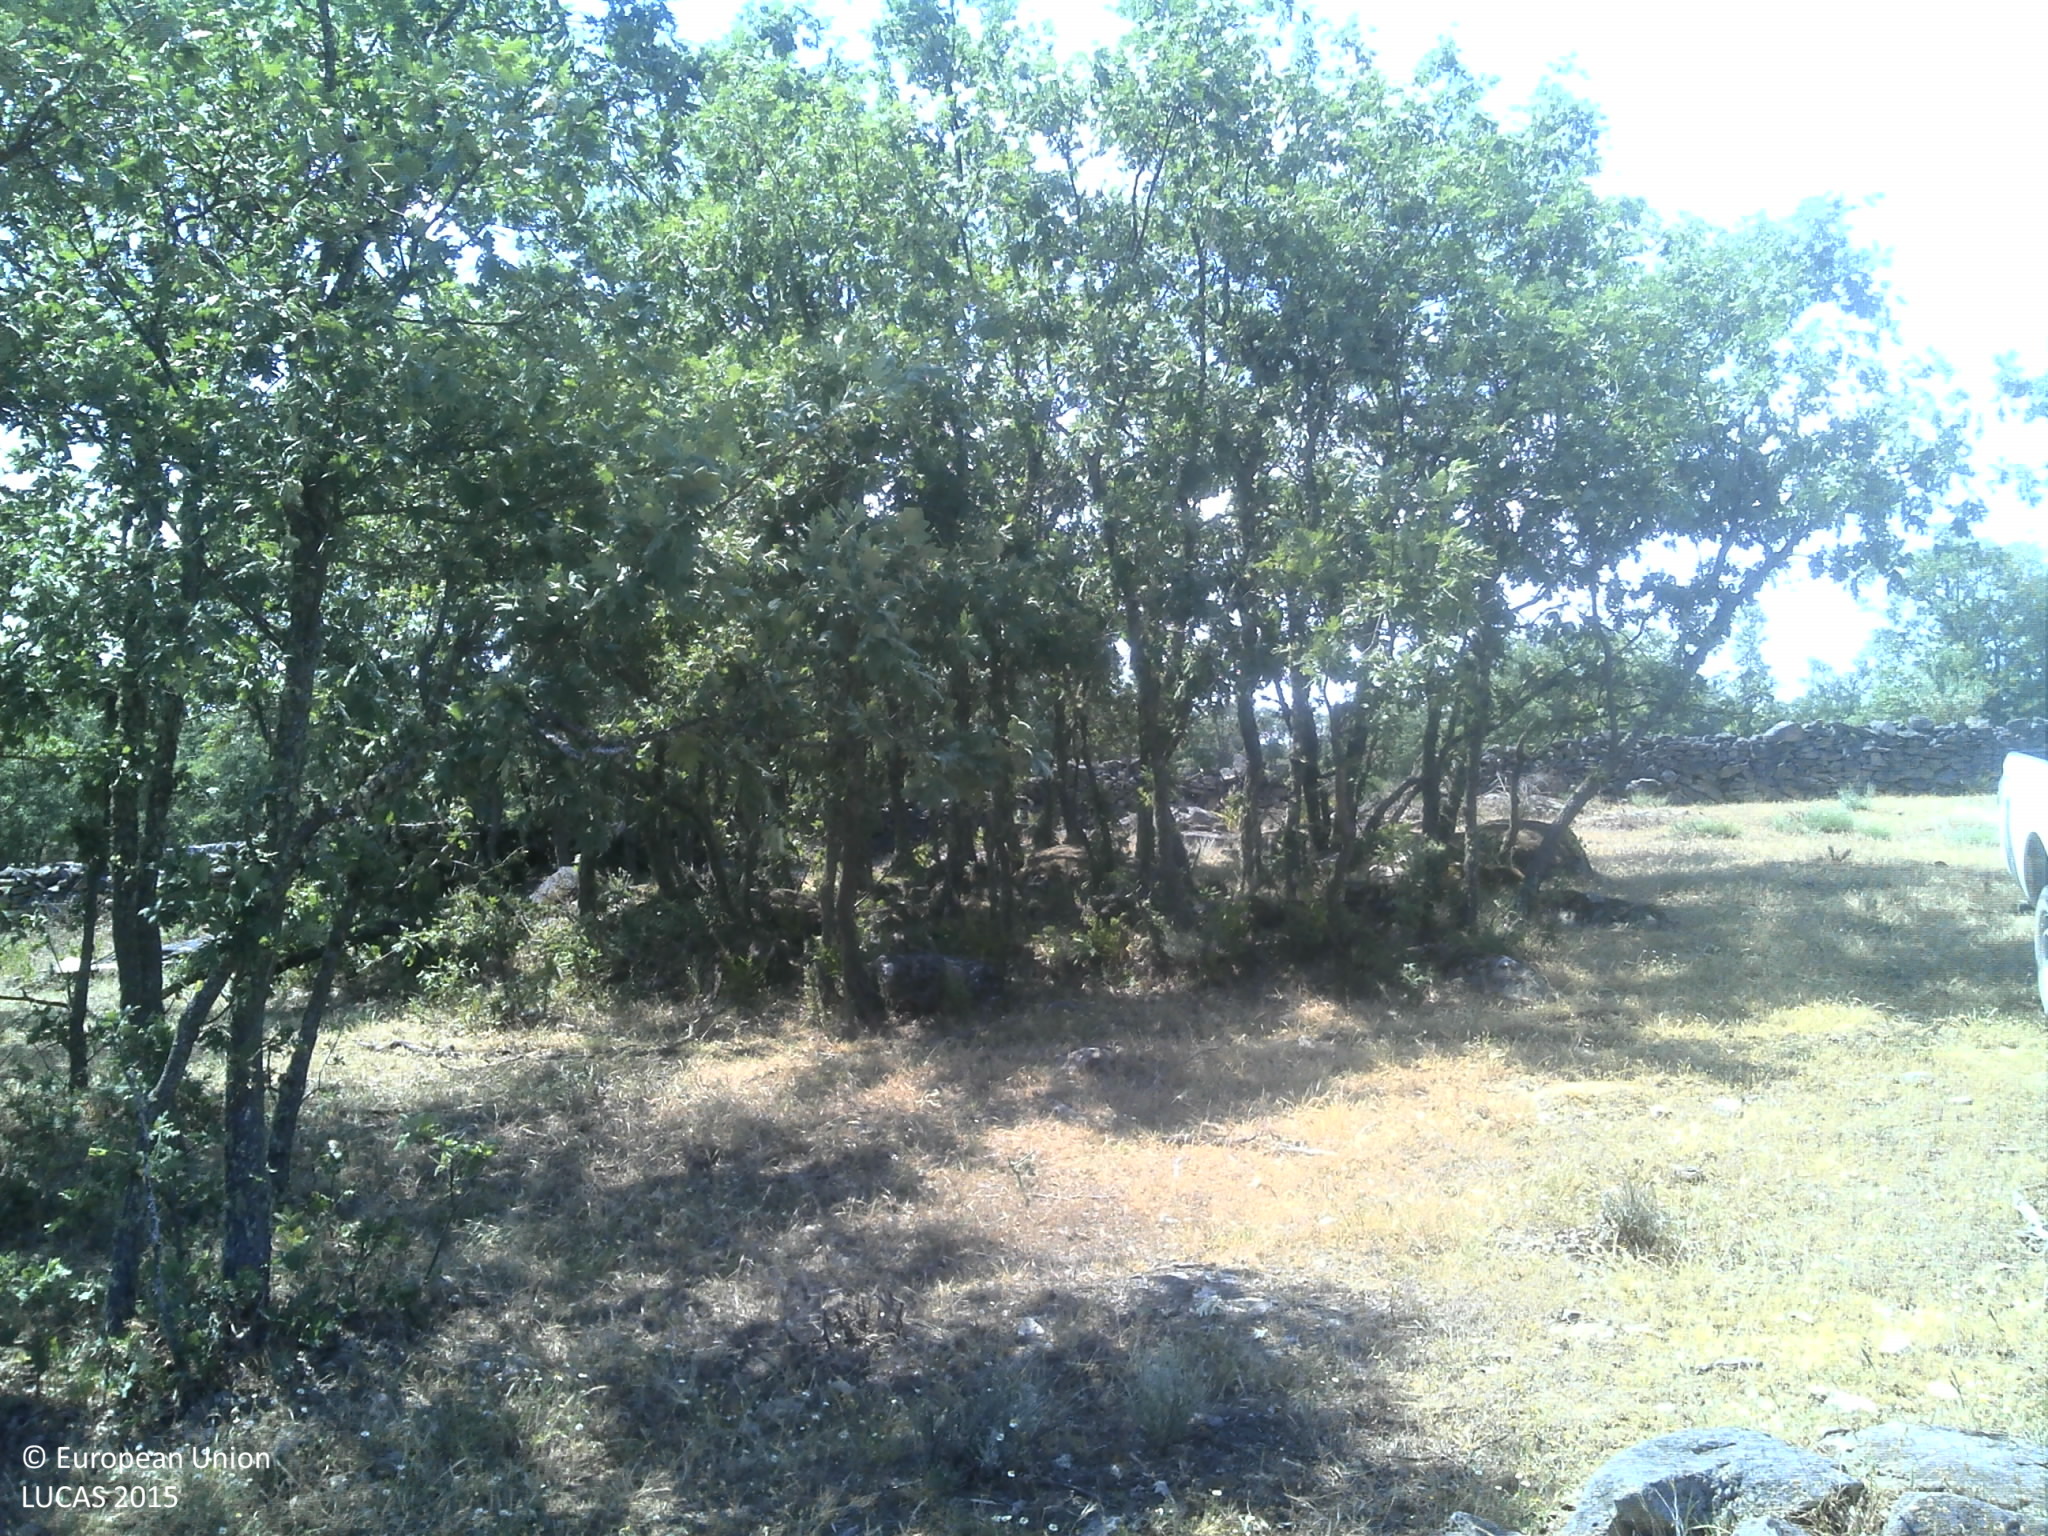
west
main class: Grassland
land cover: Grassland with sparse tree/shrub cover
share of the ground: 25 - 50 %
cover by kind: unconsolidated bare surface 40 %, herbaceous plants 35 %, broadleaved forest trees 5 %, shrubs 5 %
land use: Agriculture (excluding fallow land and kitchen gardens)
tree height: > 5 m
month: June
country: PT
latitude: 40.5230
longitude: -6.8935
